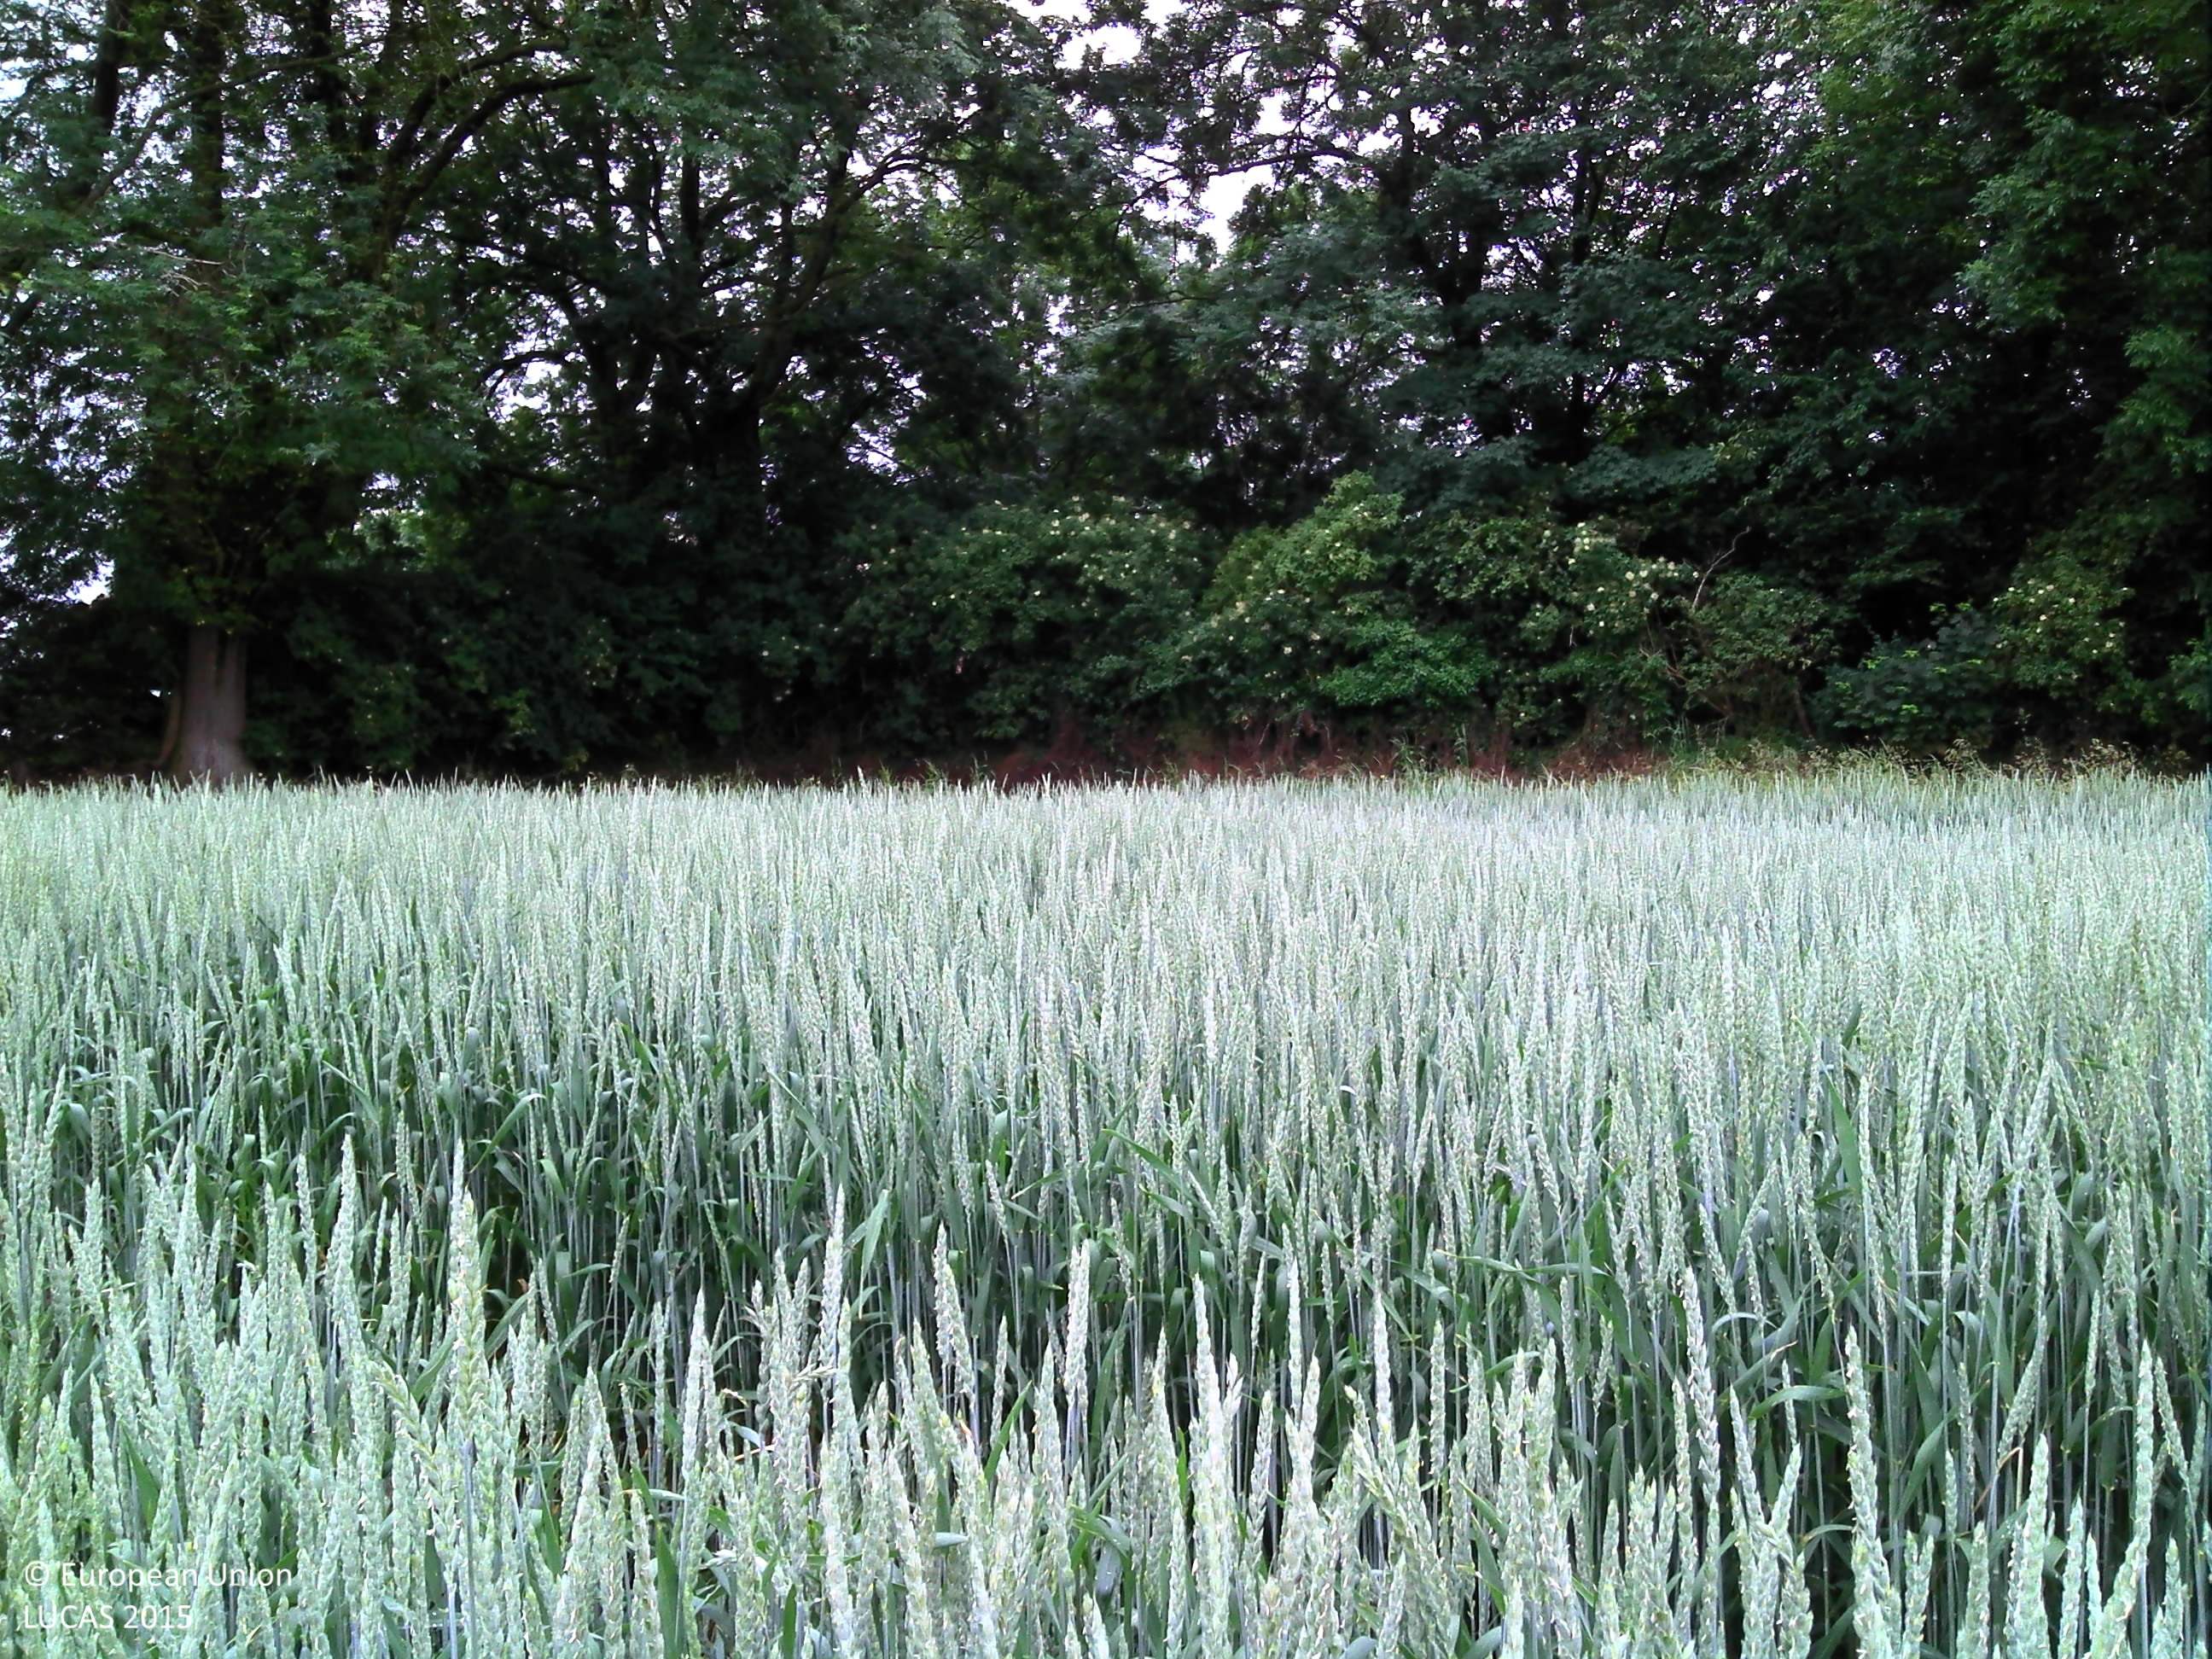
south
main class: Cropland
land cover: Other cereals
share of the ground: > 75 %
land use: Agriculture (excluding fallow land and kitchen gardens)
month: June
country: BE
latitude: 50.7070
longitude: 5.4809
